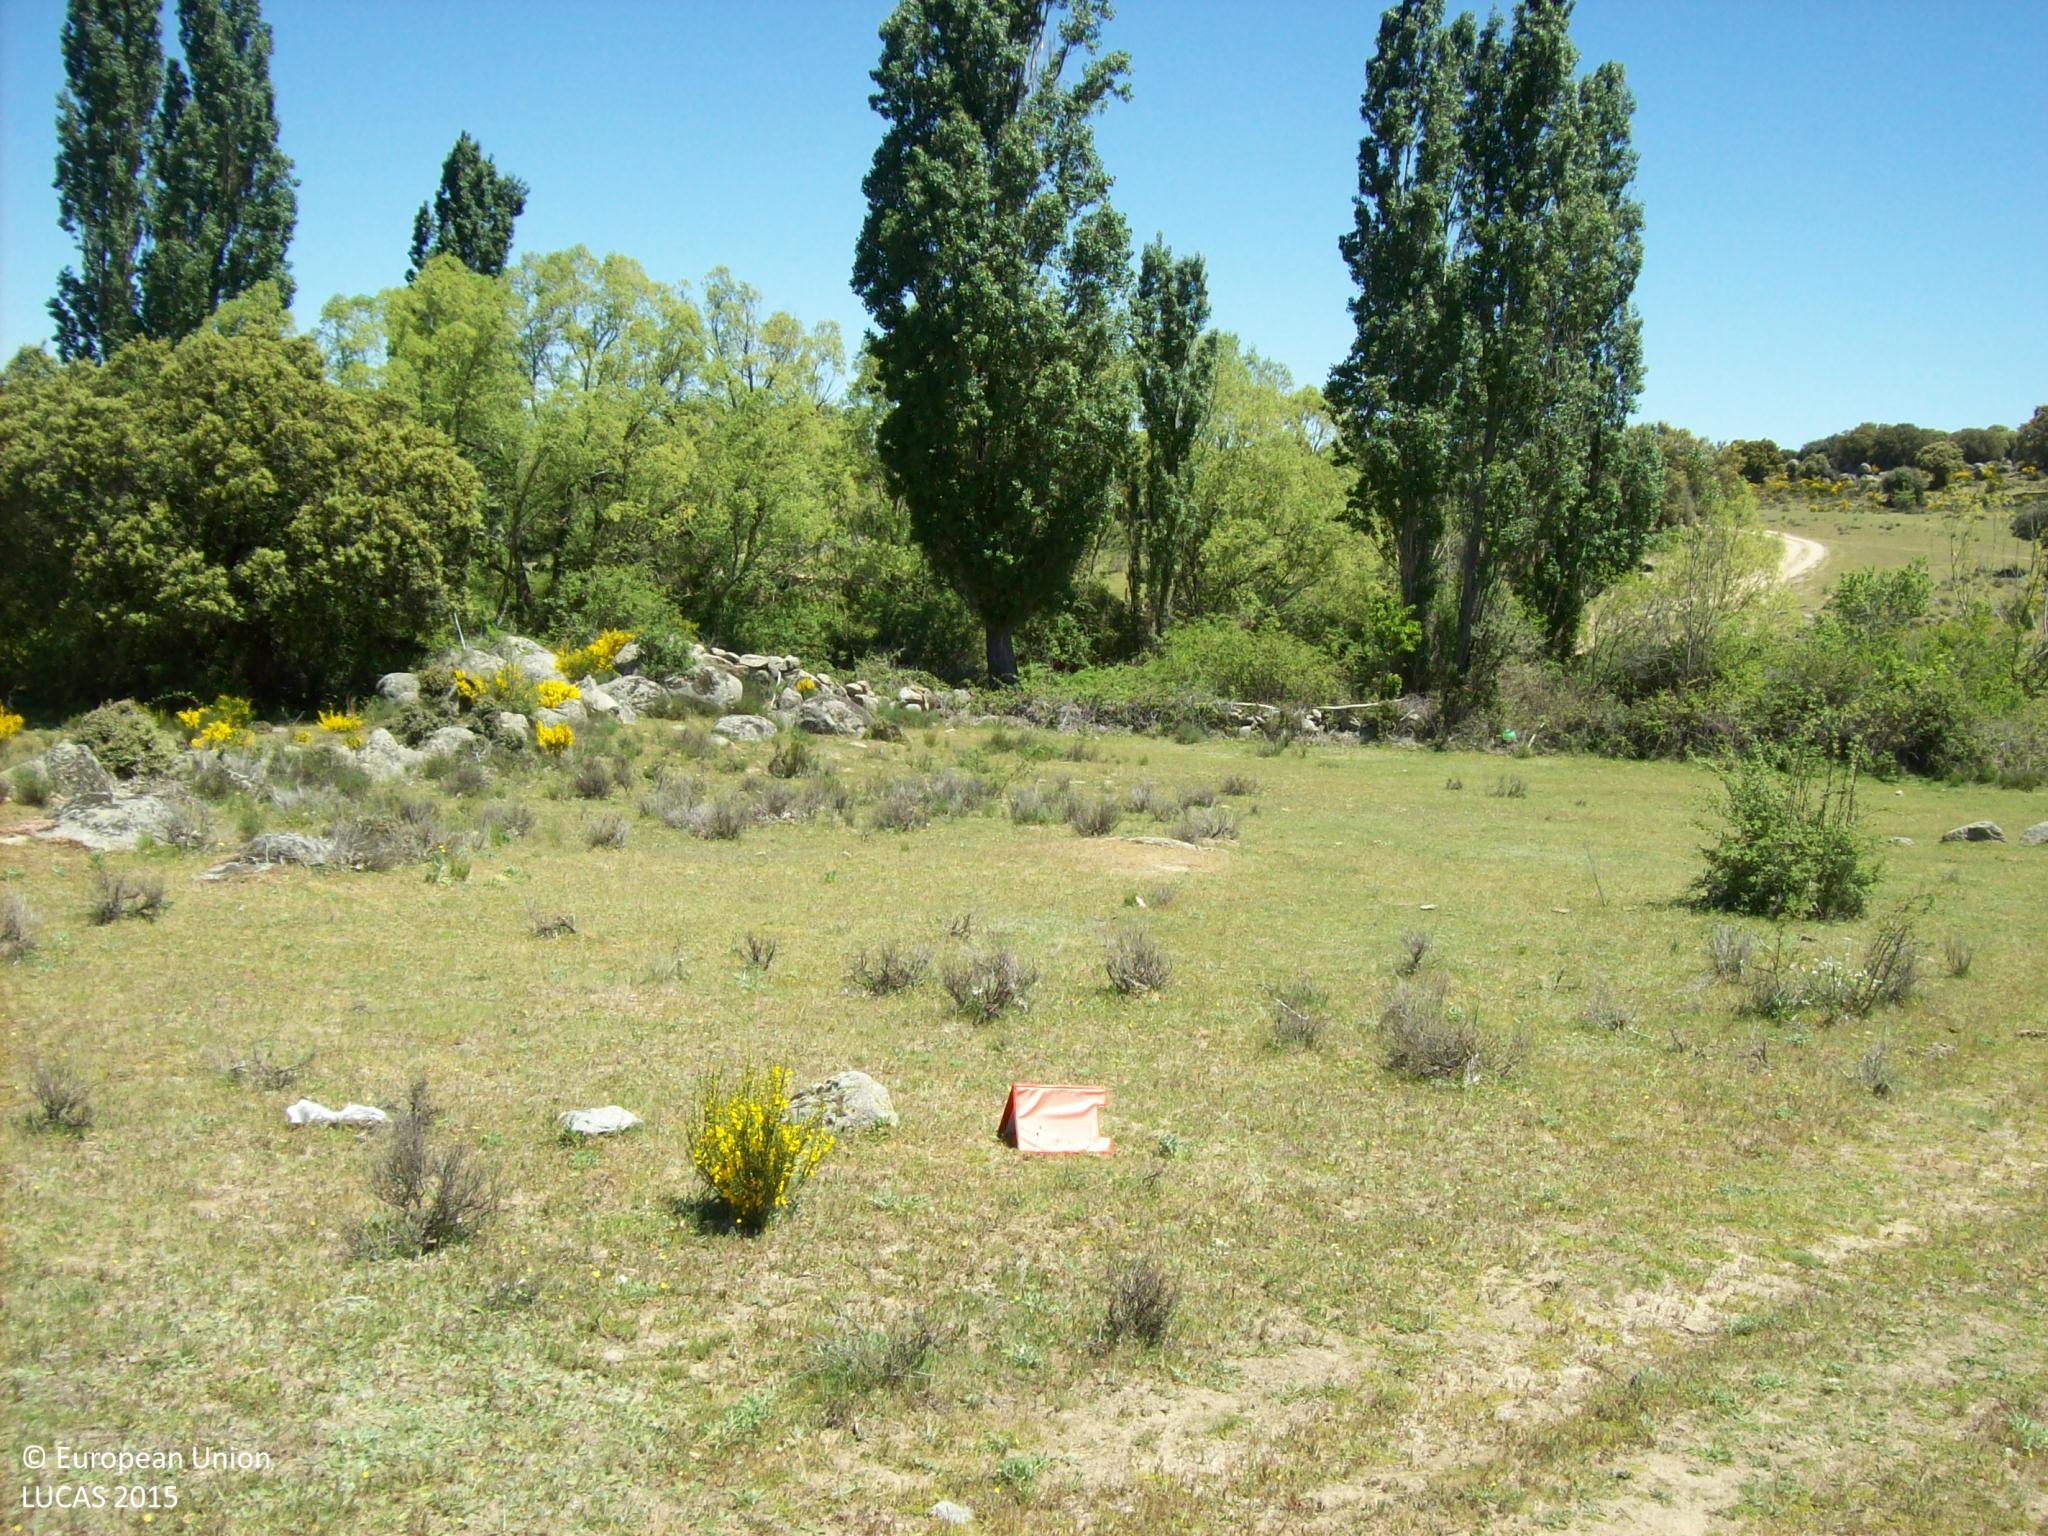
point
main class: Grassland
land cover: Grassland without tree/shrub cover
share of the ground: > 75 %
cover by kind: herbaceous plants 90 %, shrubs 5 %, consolidated bare surface 5 %
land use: Agriculture (excluding fallow land and kitchen gardens)
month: May
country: ES
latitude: 40.7134
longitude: -4.9399
